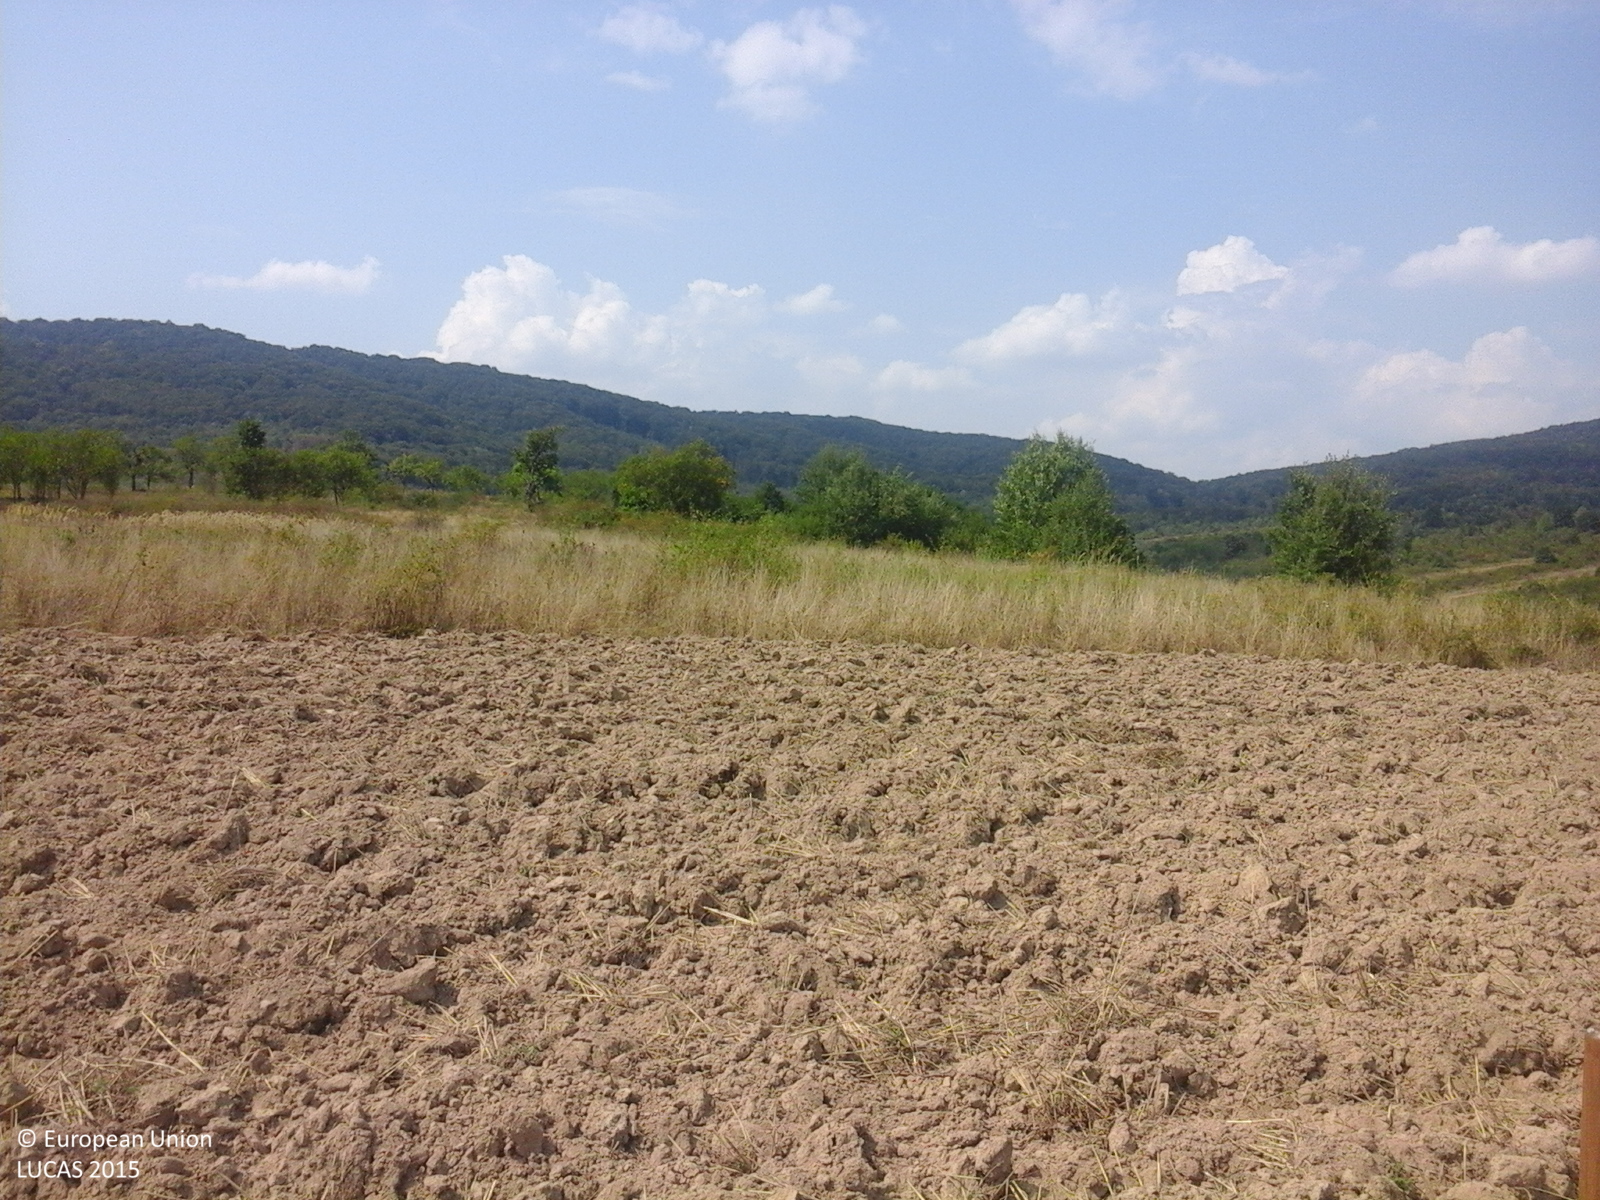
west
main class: Cropland
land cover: Common wheat
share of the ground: < 10 %
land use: Agriculture (excluding fallow land and kitchen gardens)
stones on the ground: < 10 %
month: August
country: RO
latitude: 46.3246
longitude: 22.1903
